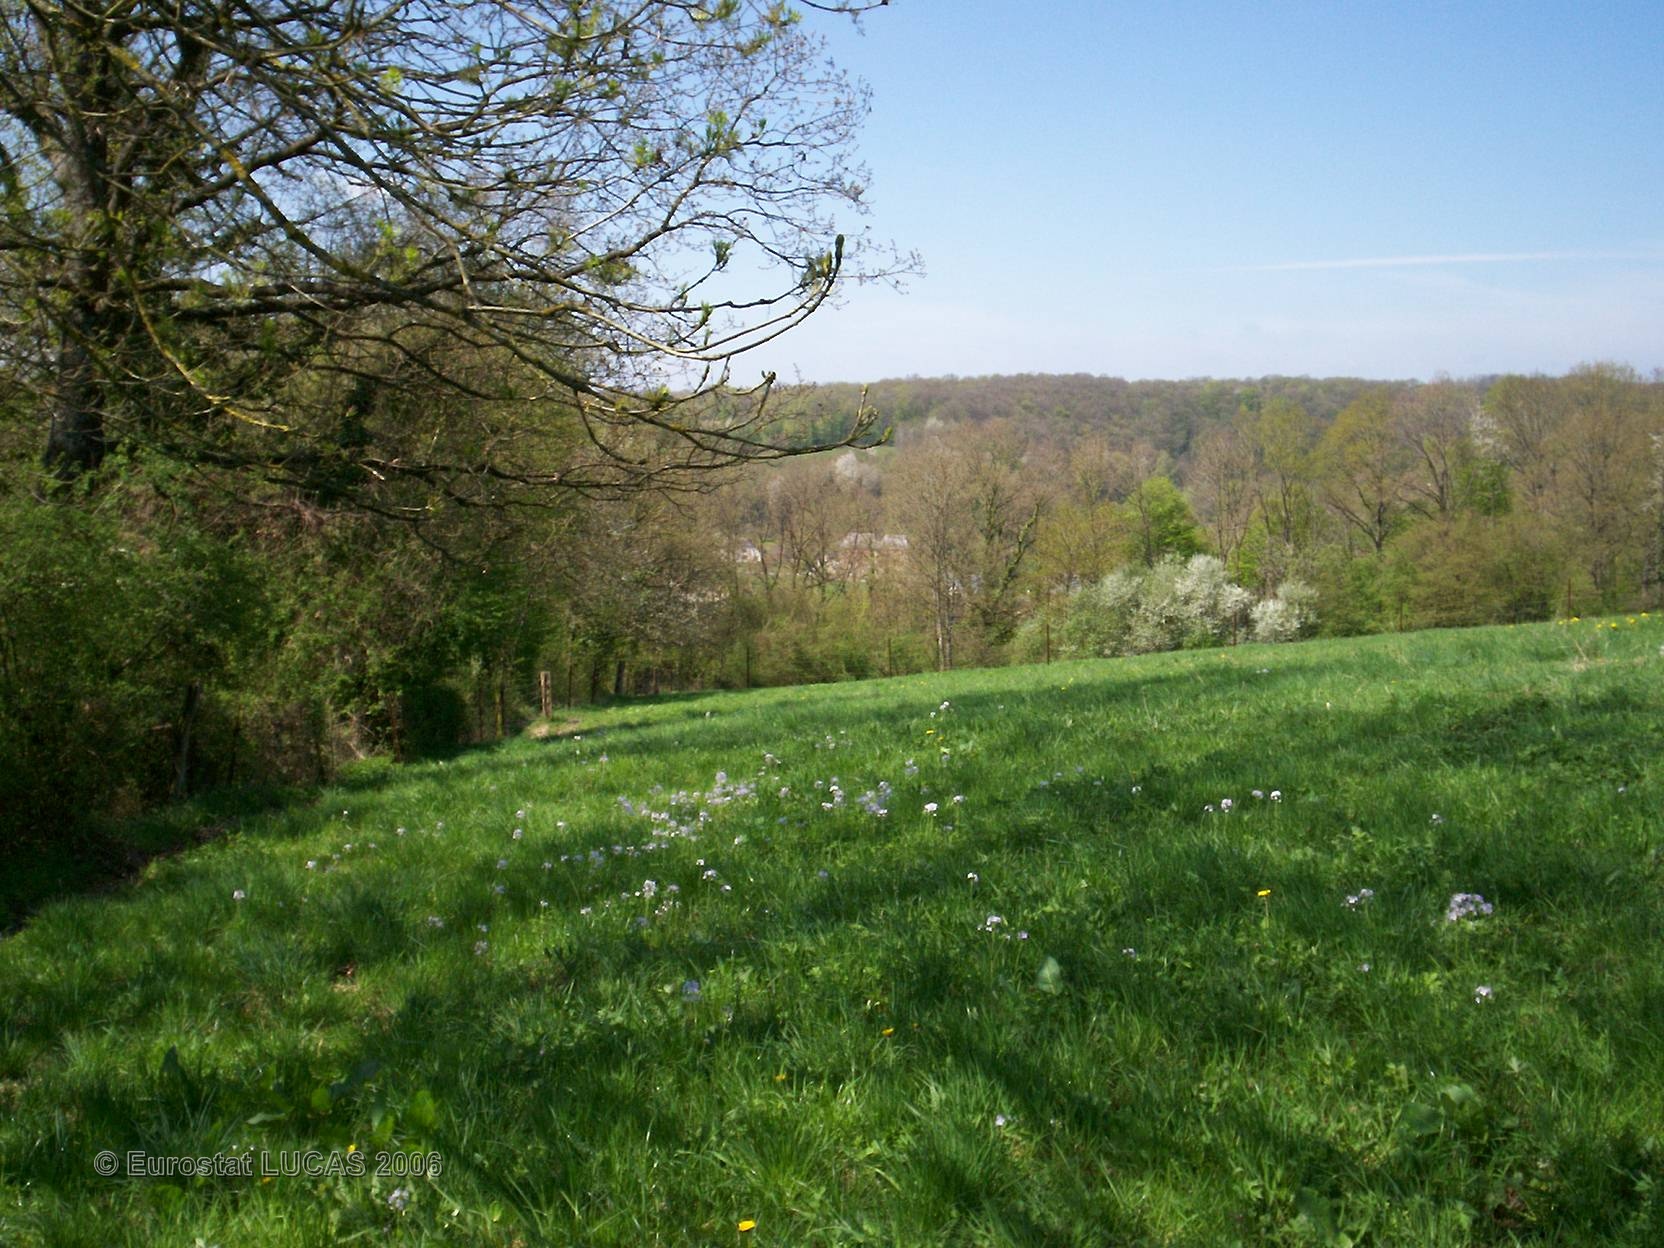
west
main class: Grassland
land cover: Grassland without tree/shrub cover
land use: Agriculture (excluding fallow land and kitchen gardens)
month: April
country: FR
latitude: 49.6673
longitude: 4.3844
